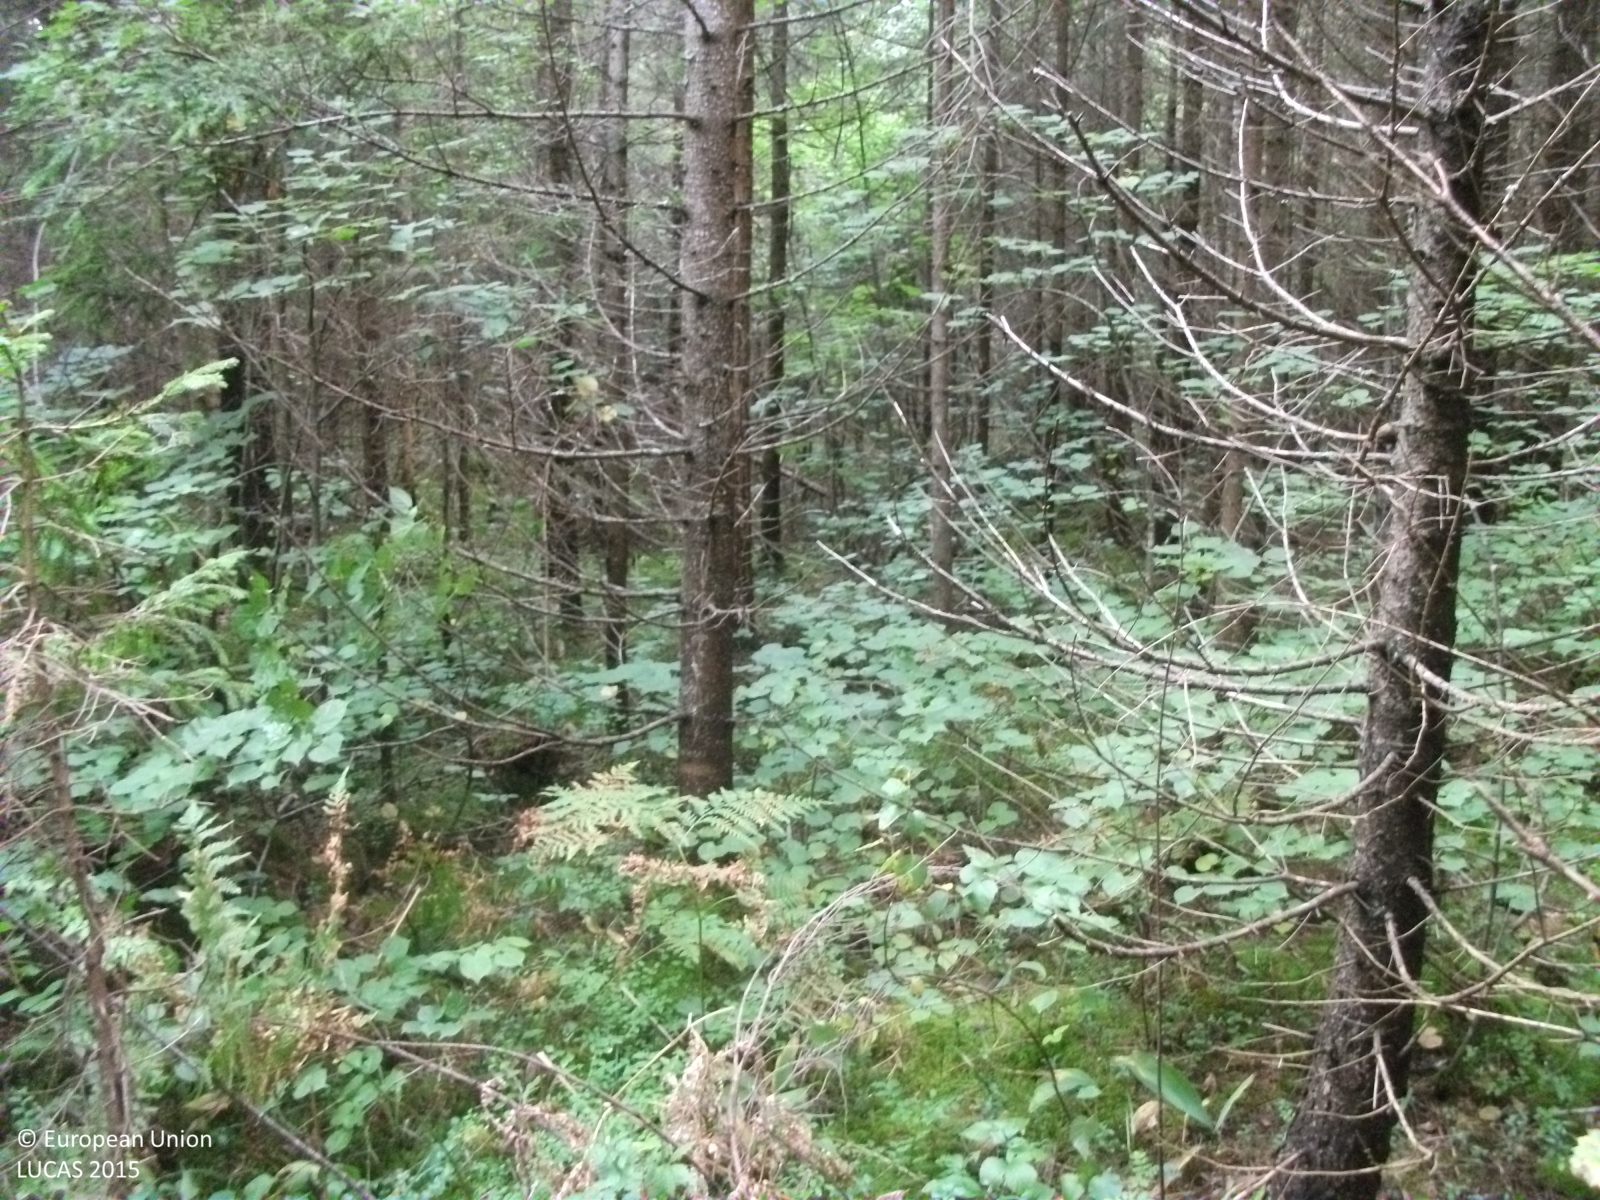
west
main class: Woodland
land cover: Spruce dominated coniferous woodland
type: hemiboreal forest and nemoral coniferous forest and mixed broadleaved-coniferous forest
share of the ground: > 75 %
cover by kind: coniferous forest trees 90 %, broadleaved forest trees 5 %, shrubs 5 %
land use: Forestry
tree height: > 5 m
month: September
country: LV
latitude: 57.6034
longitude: 24.3962
